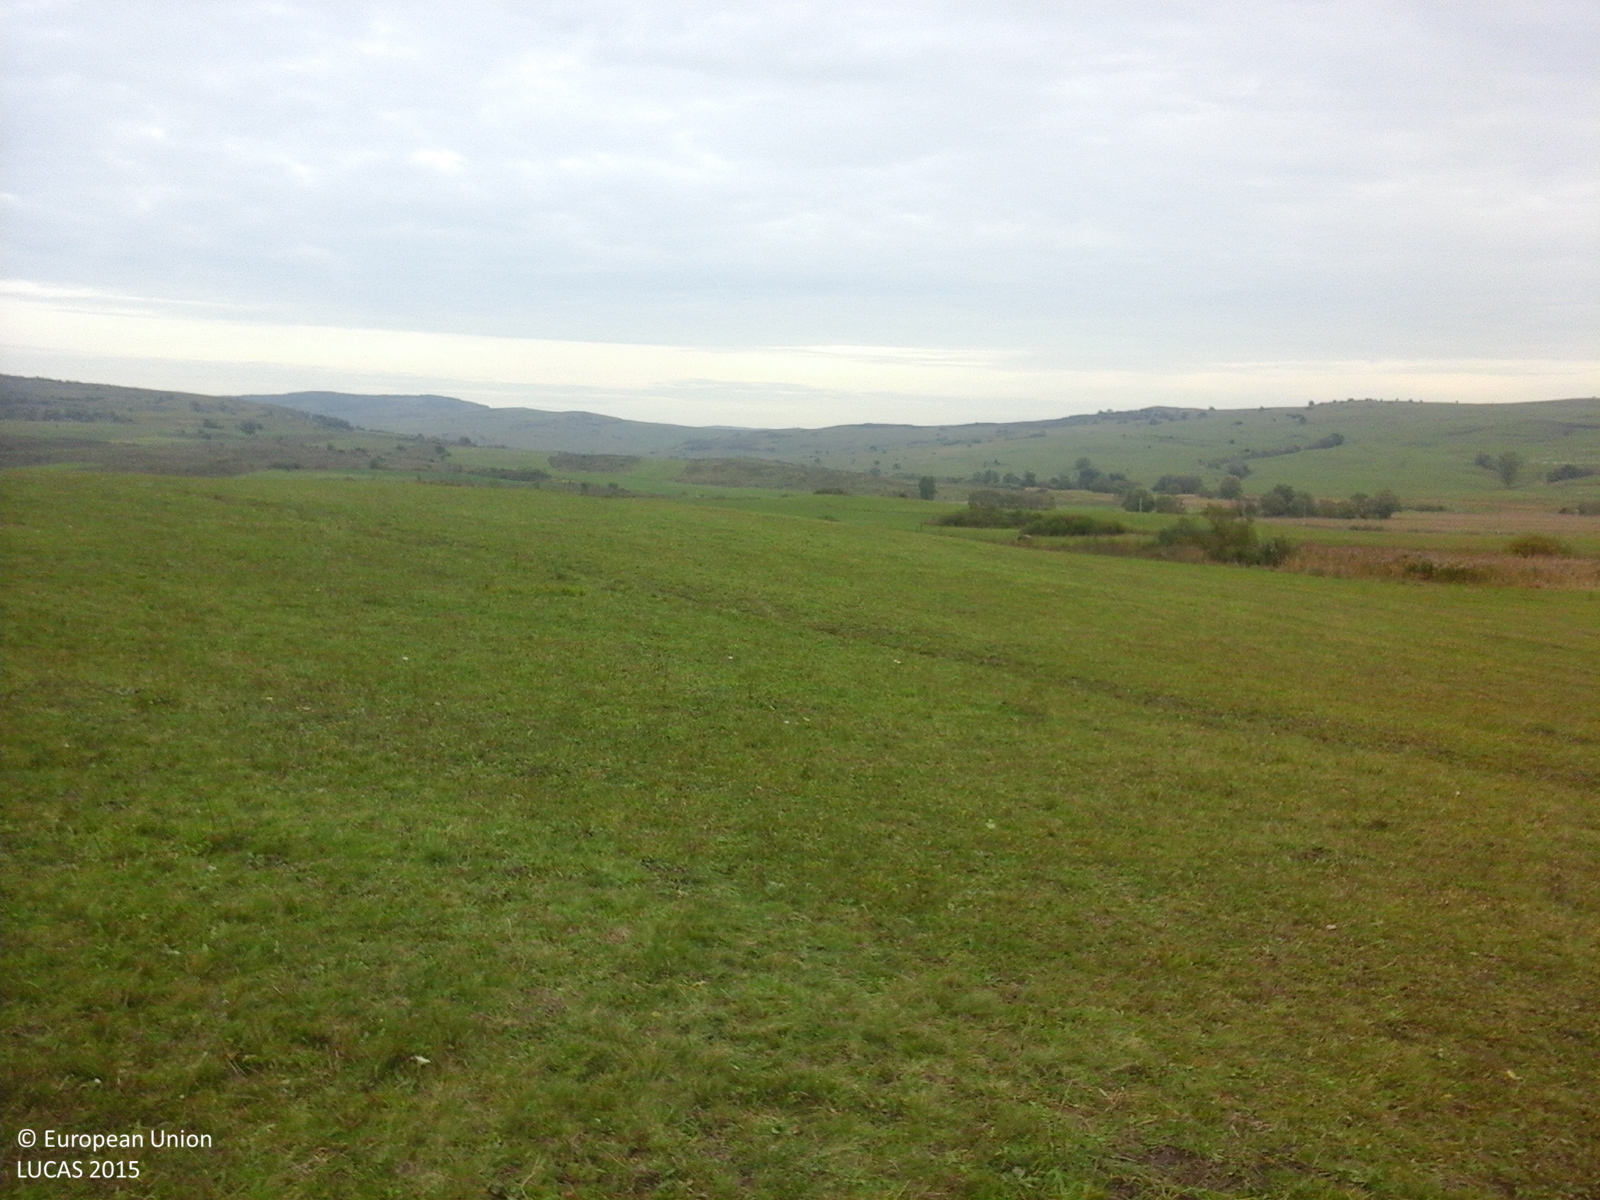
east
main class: Grassland
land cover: Grassland without tree/shrub cover
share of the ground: > 75 %
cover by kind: herbaceous plants 100 %
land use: Agriculture (excluding fallow land and kitchen gardens)
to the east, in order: Grassland without tree/shrub cover; Abandoned hedges; Grassland without tree/shrub cover
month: October
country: RO
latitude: 46.0521
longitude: 24.8904
